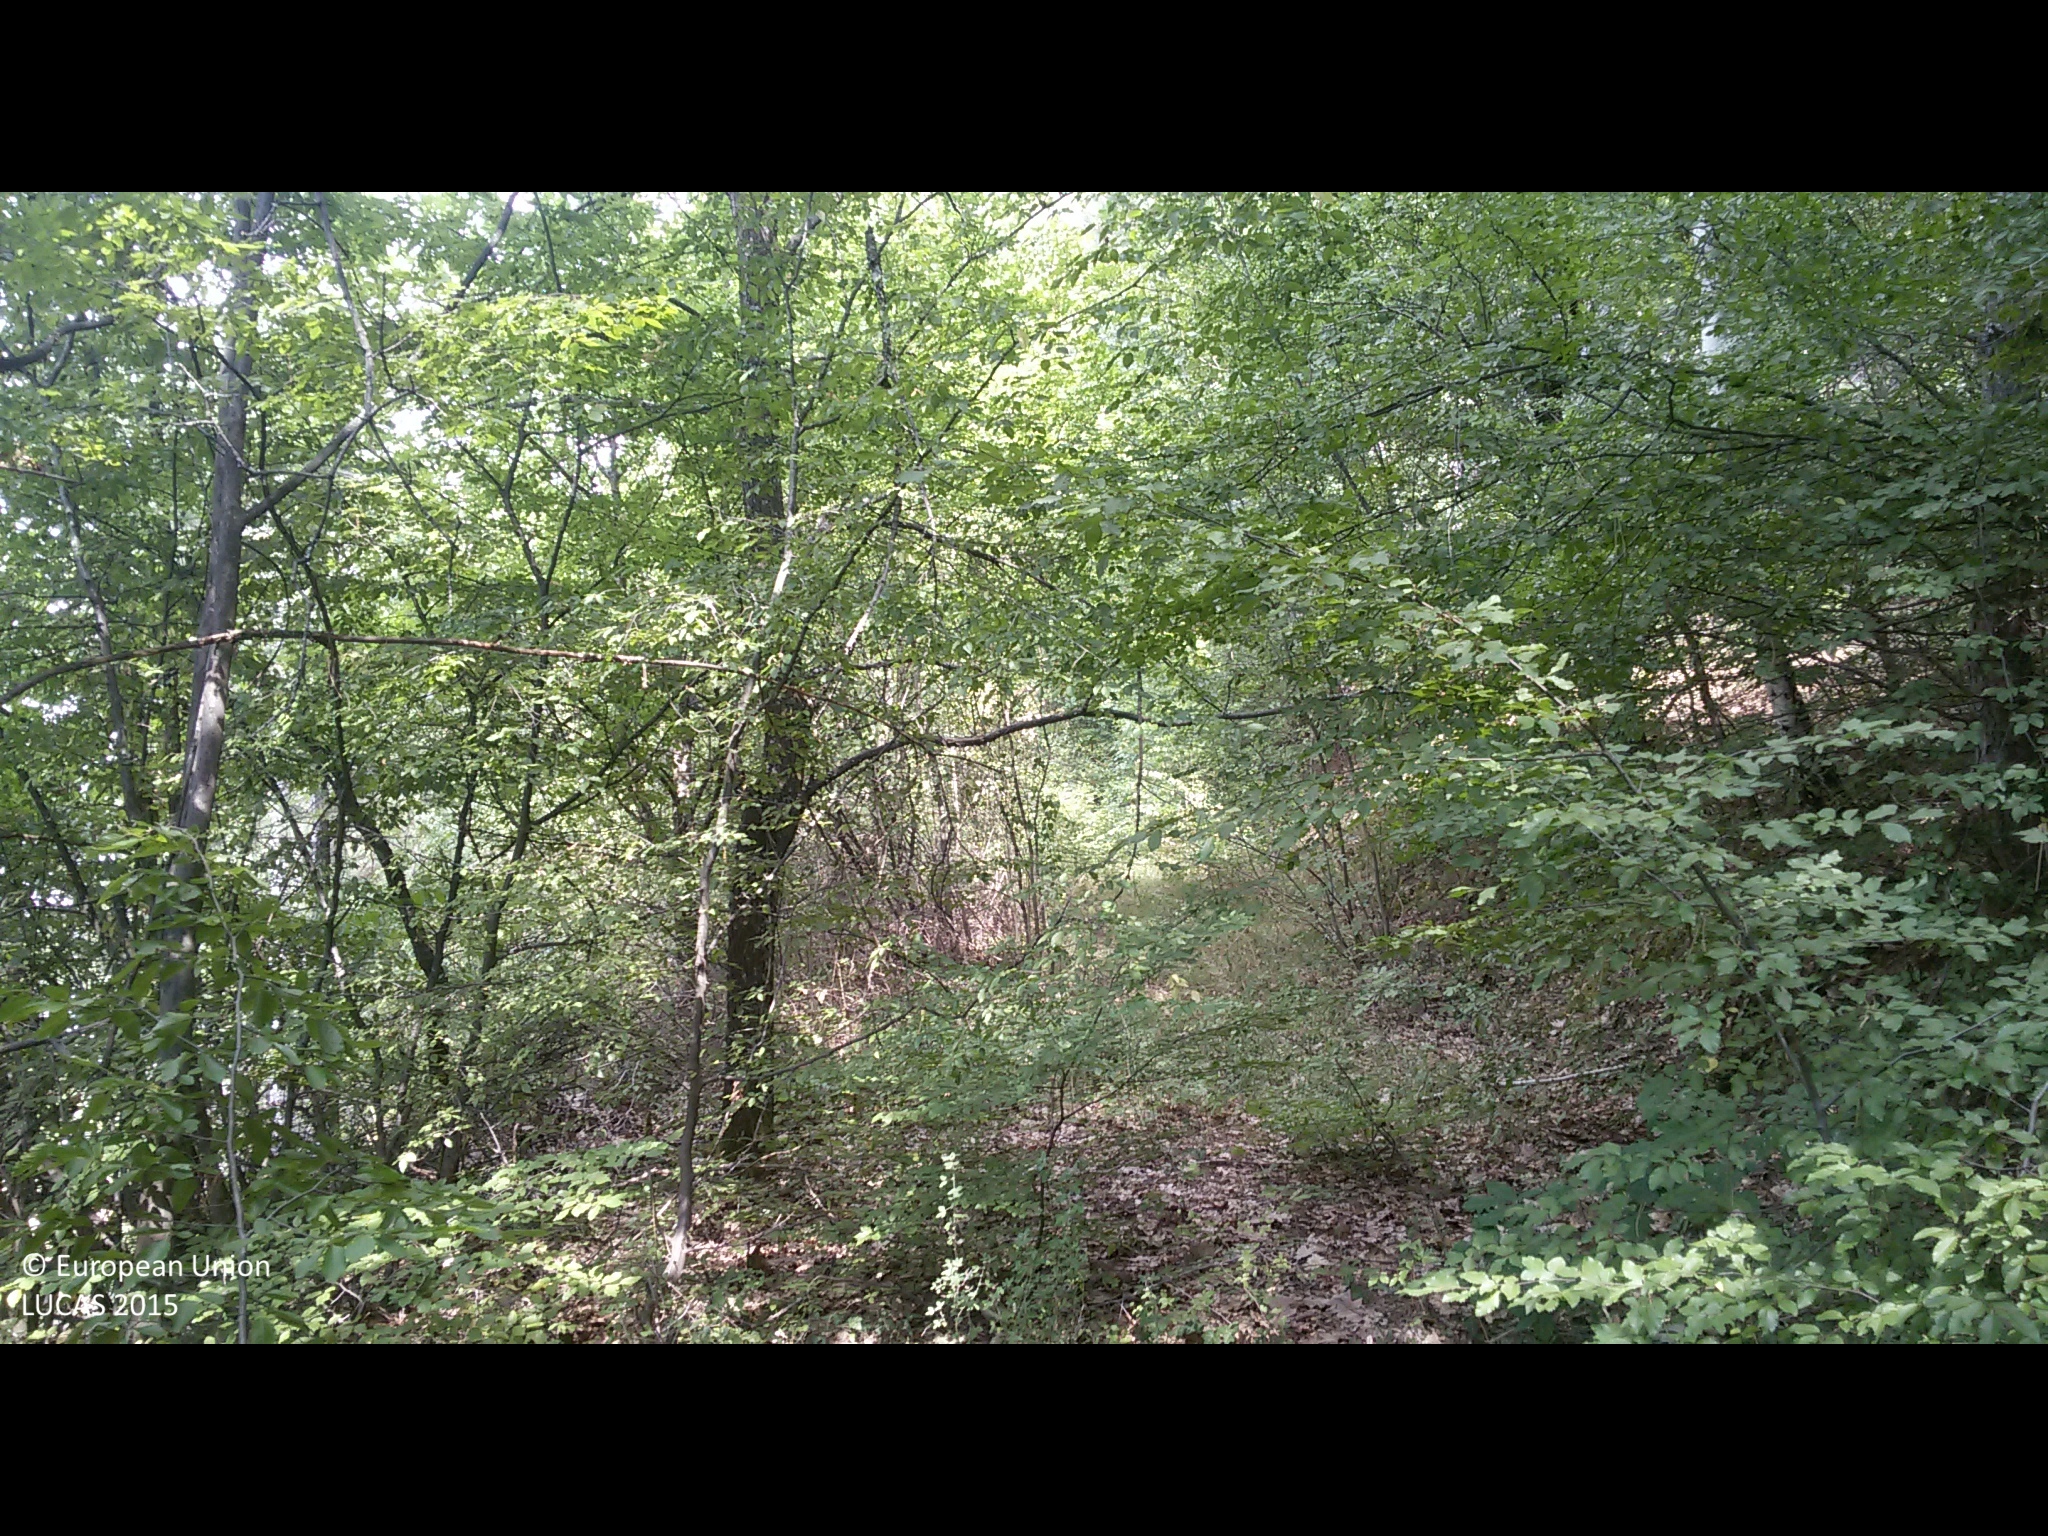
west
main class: Woodland
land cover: Broadleaved woodland
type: mesophytic deciduous forest
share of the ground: > 75 %
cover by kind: broadleaved forest trees 95 %, coniferous forest trees 5 %
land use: Forestry
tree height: > 5 m
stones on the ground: < 10 %
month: August
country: BG
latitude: 42.0327
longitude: 23.1306
